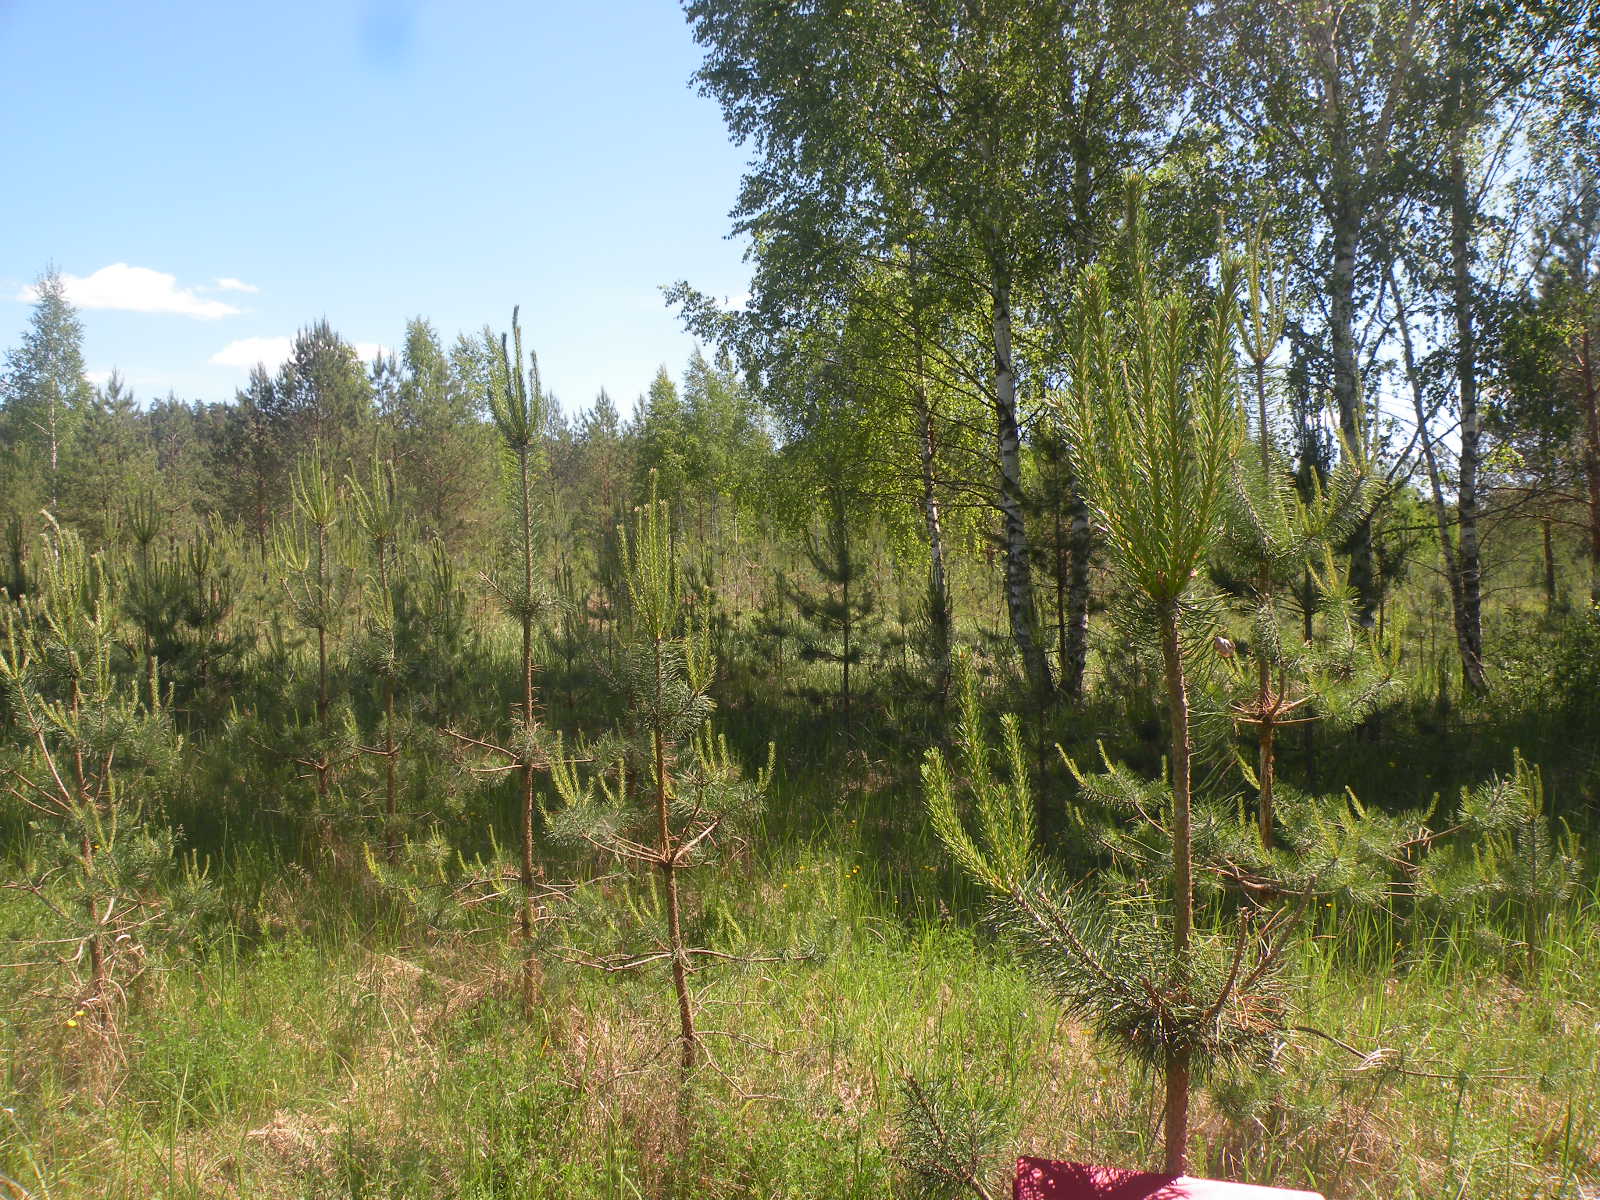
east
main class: Woodland
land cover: Pine dominated coniferous woodland
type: hemiboreal forest and nemoral coniferous forest and mixed broadleaved-coniferous forest
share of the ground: 25 - 50 %
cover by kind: herbaceous plants 55 %, coniferous forest trees 30 %, shrubs 10 %, broadleaved forest trees 5 %
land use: Forestry
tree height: < 5 m
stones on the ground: < 10 %
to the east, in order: Pine dominated coniferous woodland; Pine dominated mixed woodland; Tracks; Pine dominated mixed woodland; Pine dominated coniferous woodland; Tracks; Pine dominated mixed woodland; Pine dominated coniferous woodland
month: June
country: LV
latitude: 55.8866
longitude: 26.7372
